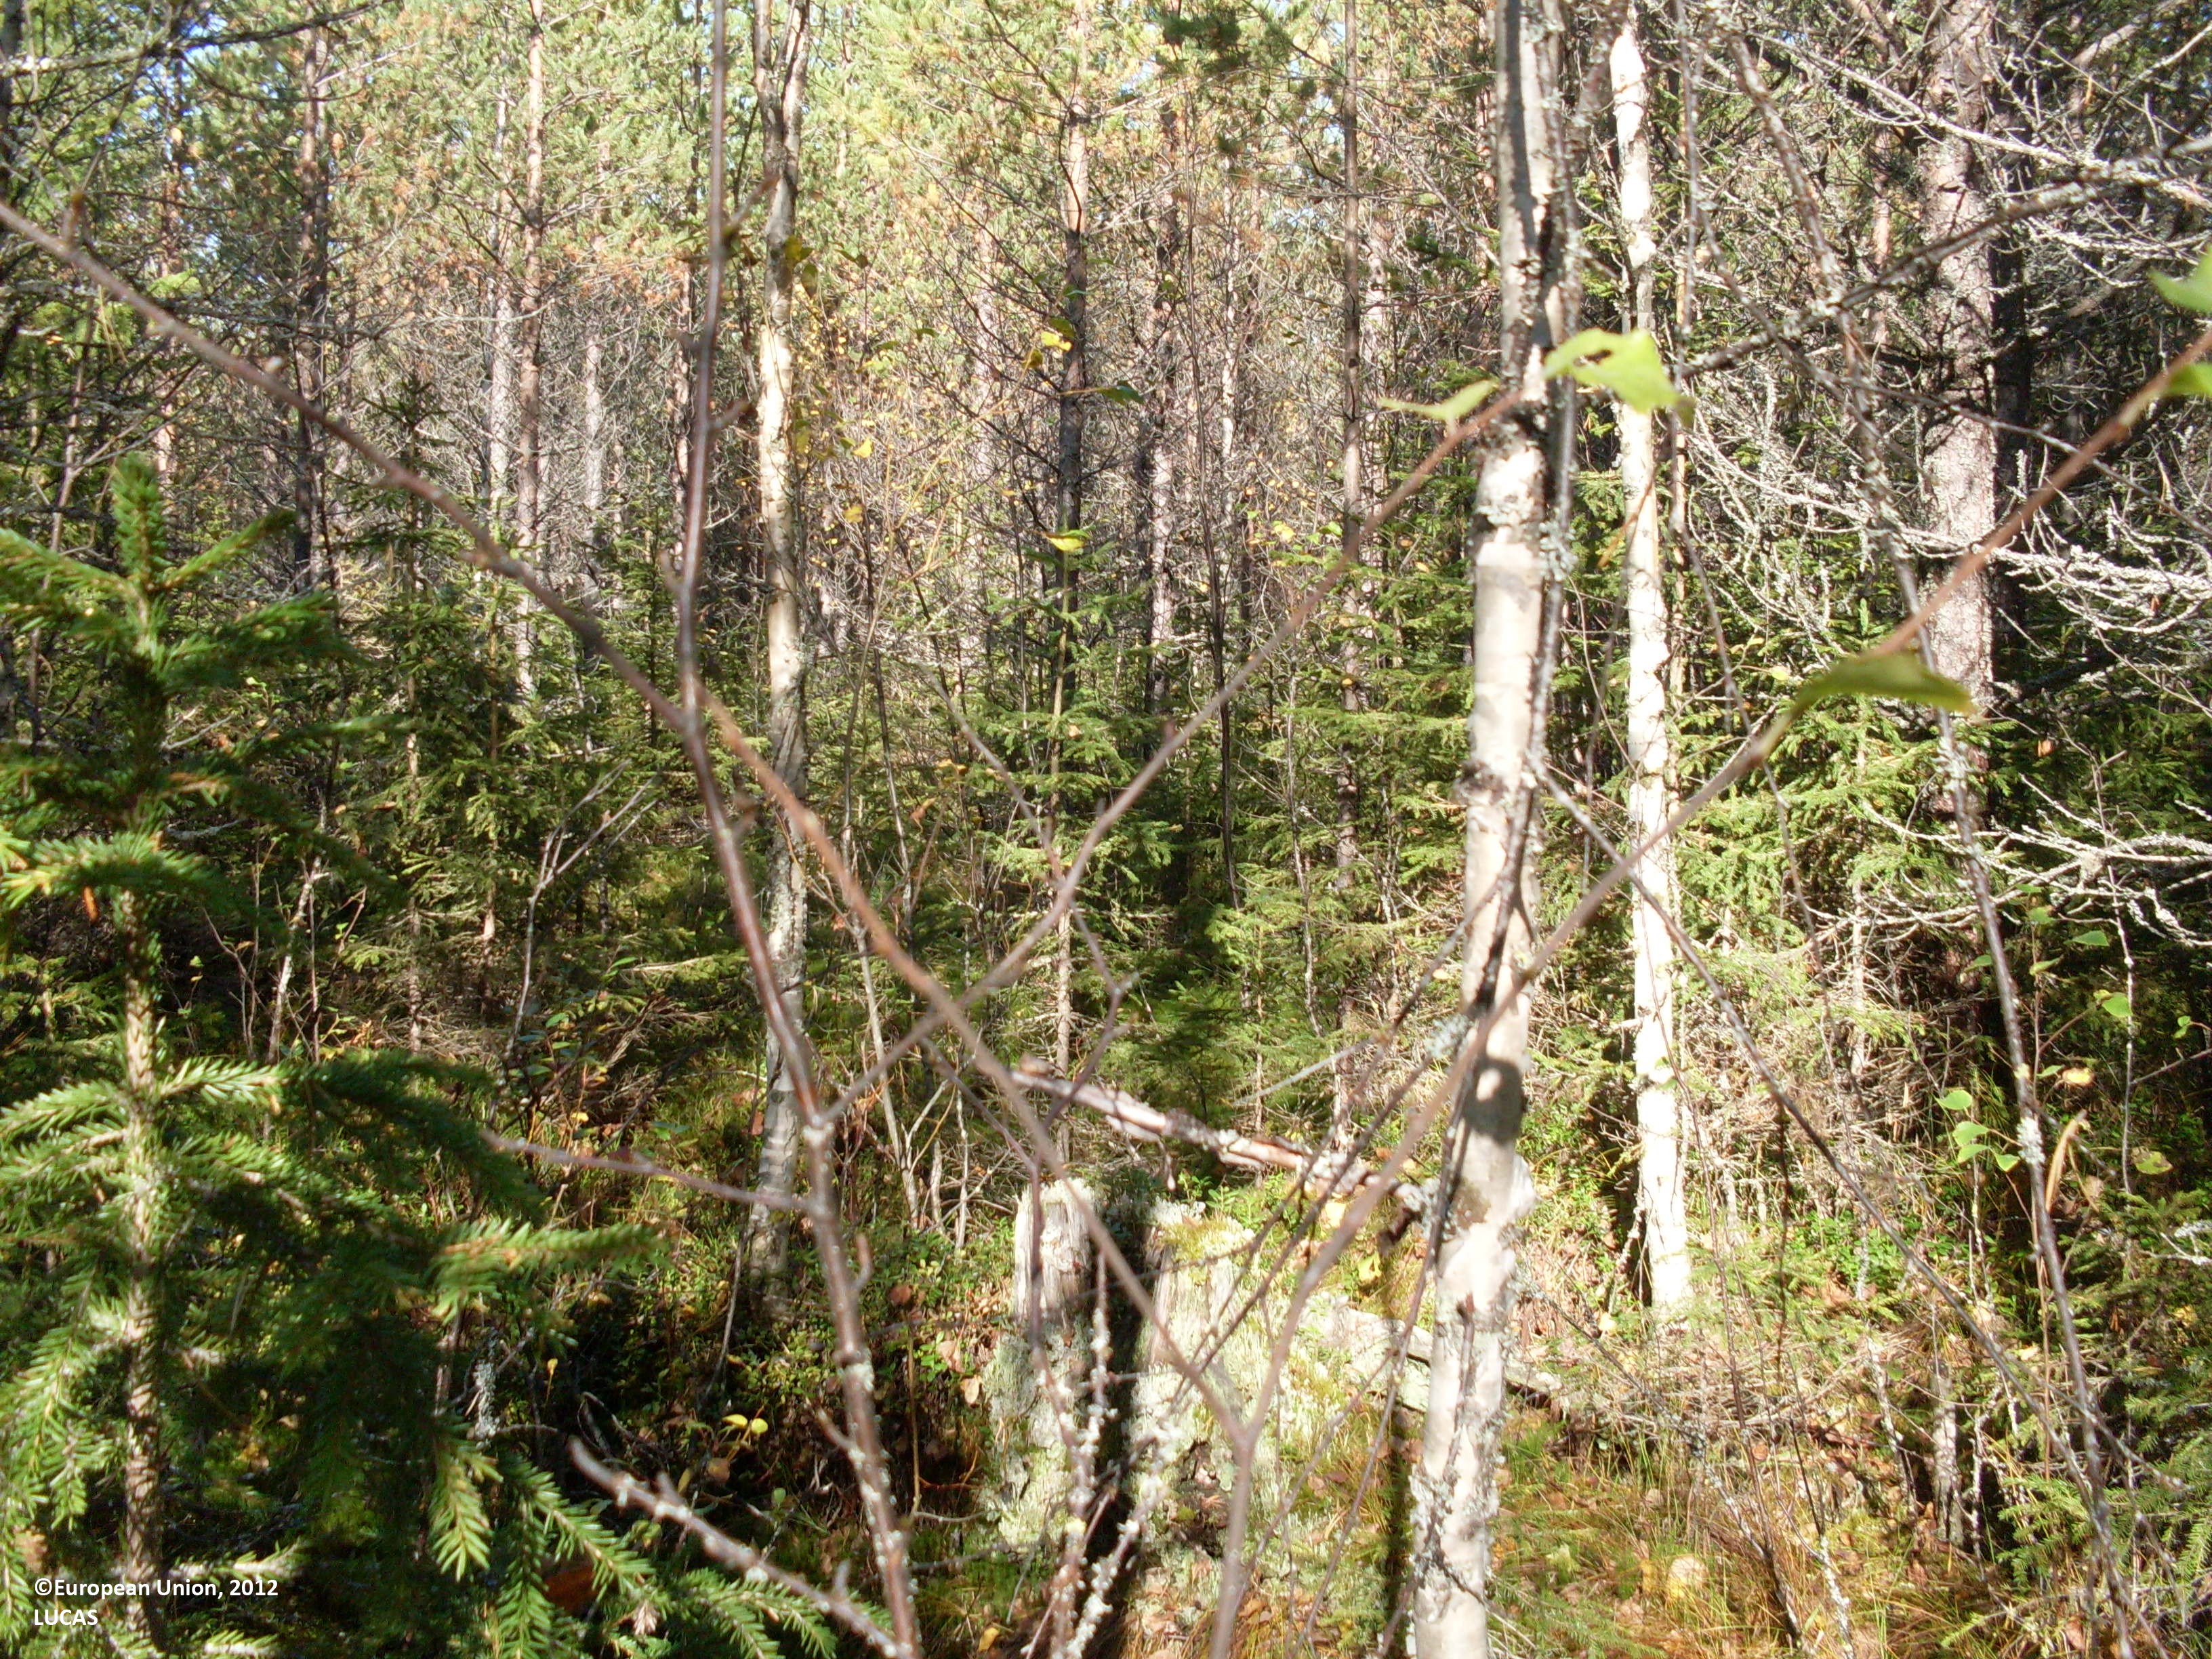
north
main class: Woodland
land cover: Pine dominated mixed woodland
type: boreal forest
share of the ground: > 75 %
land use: Forestry
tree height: > 5 m
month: September
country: FI
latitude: 64.3310
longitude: 28.5752
